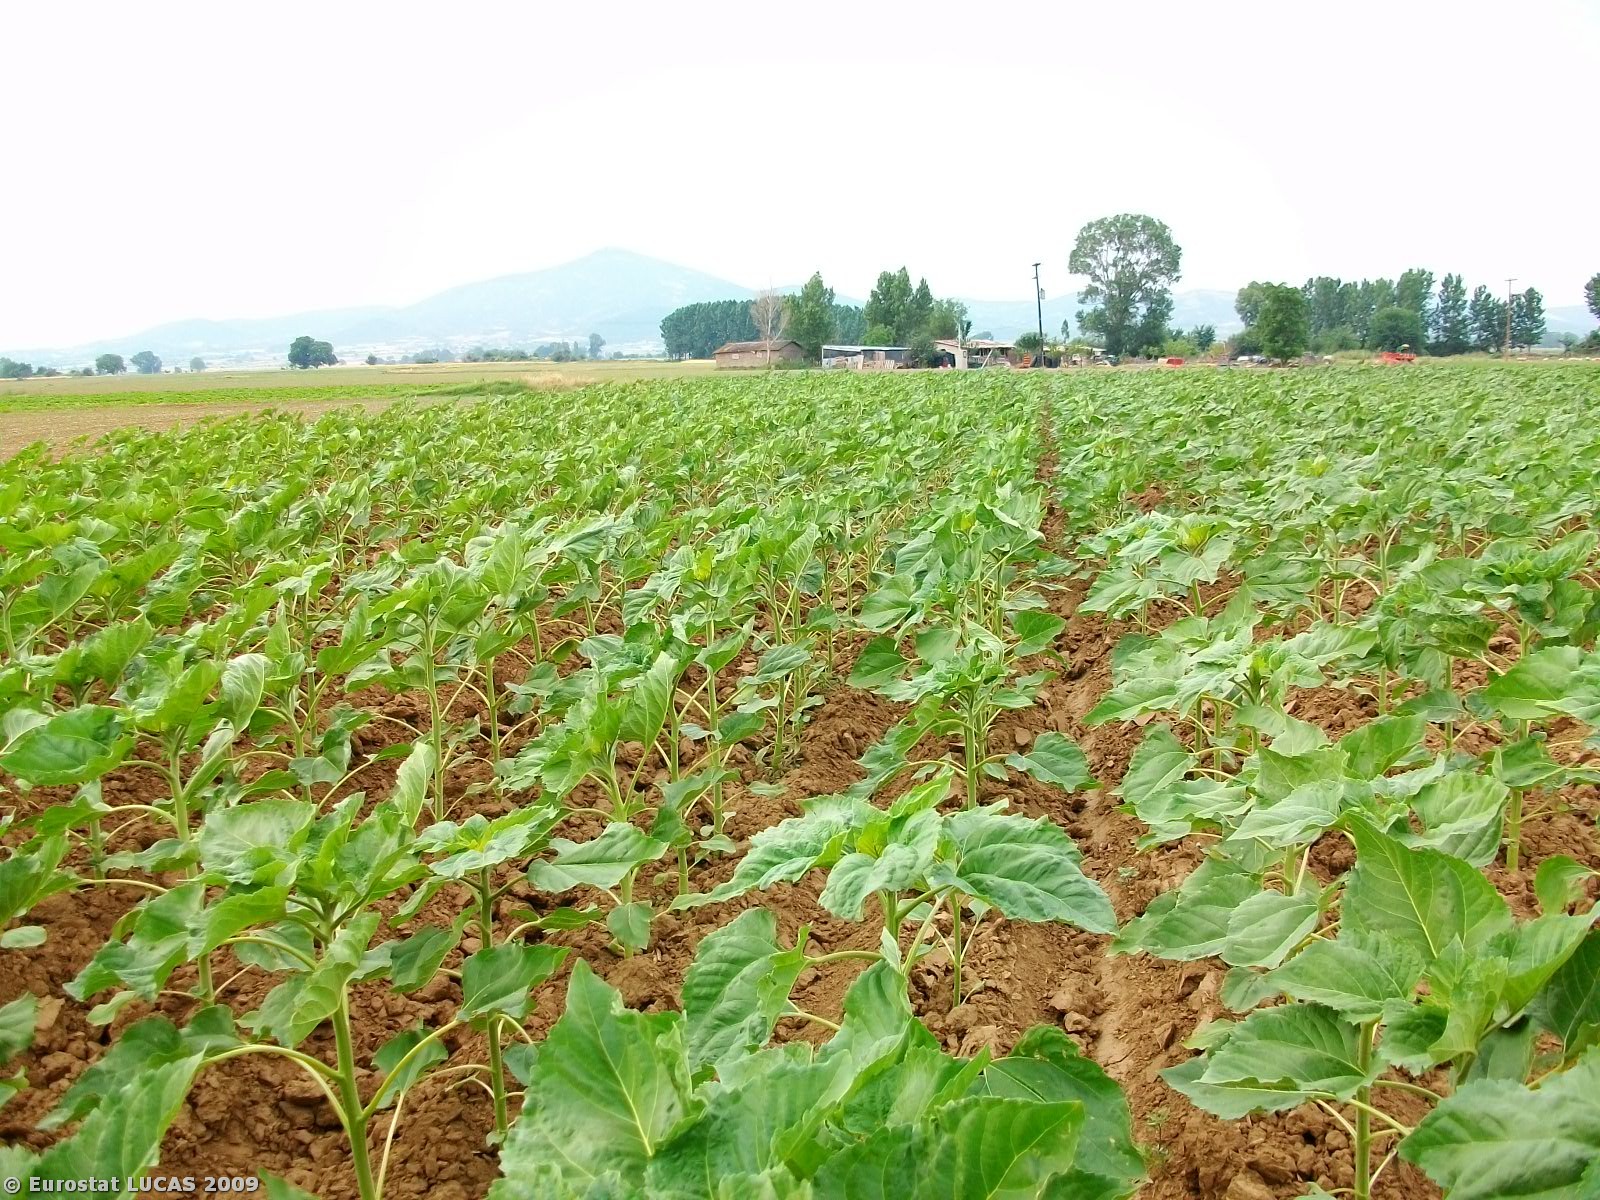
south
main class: Cropland
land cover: Sunflower
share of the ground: > 75 %
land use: Agriculture (excluding fallow land and kitchen gardens)
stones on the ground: < 10 %
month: June
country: GR
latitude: 41.0476
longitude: 25.5058
